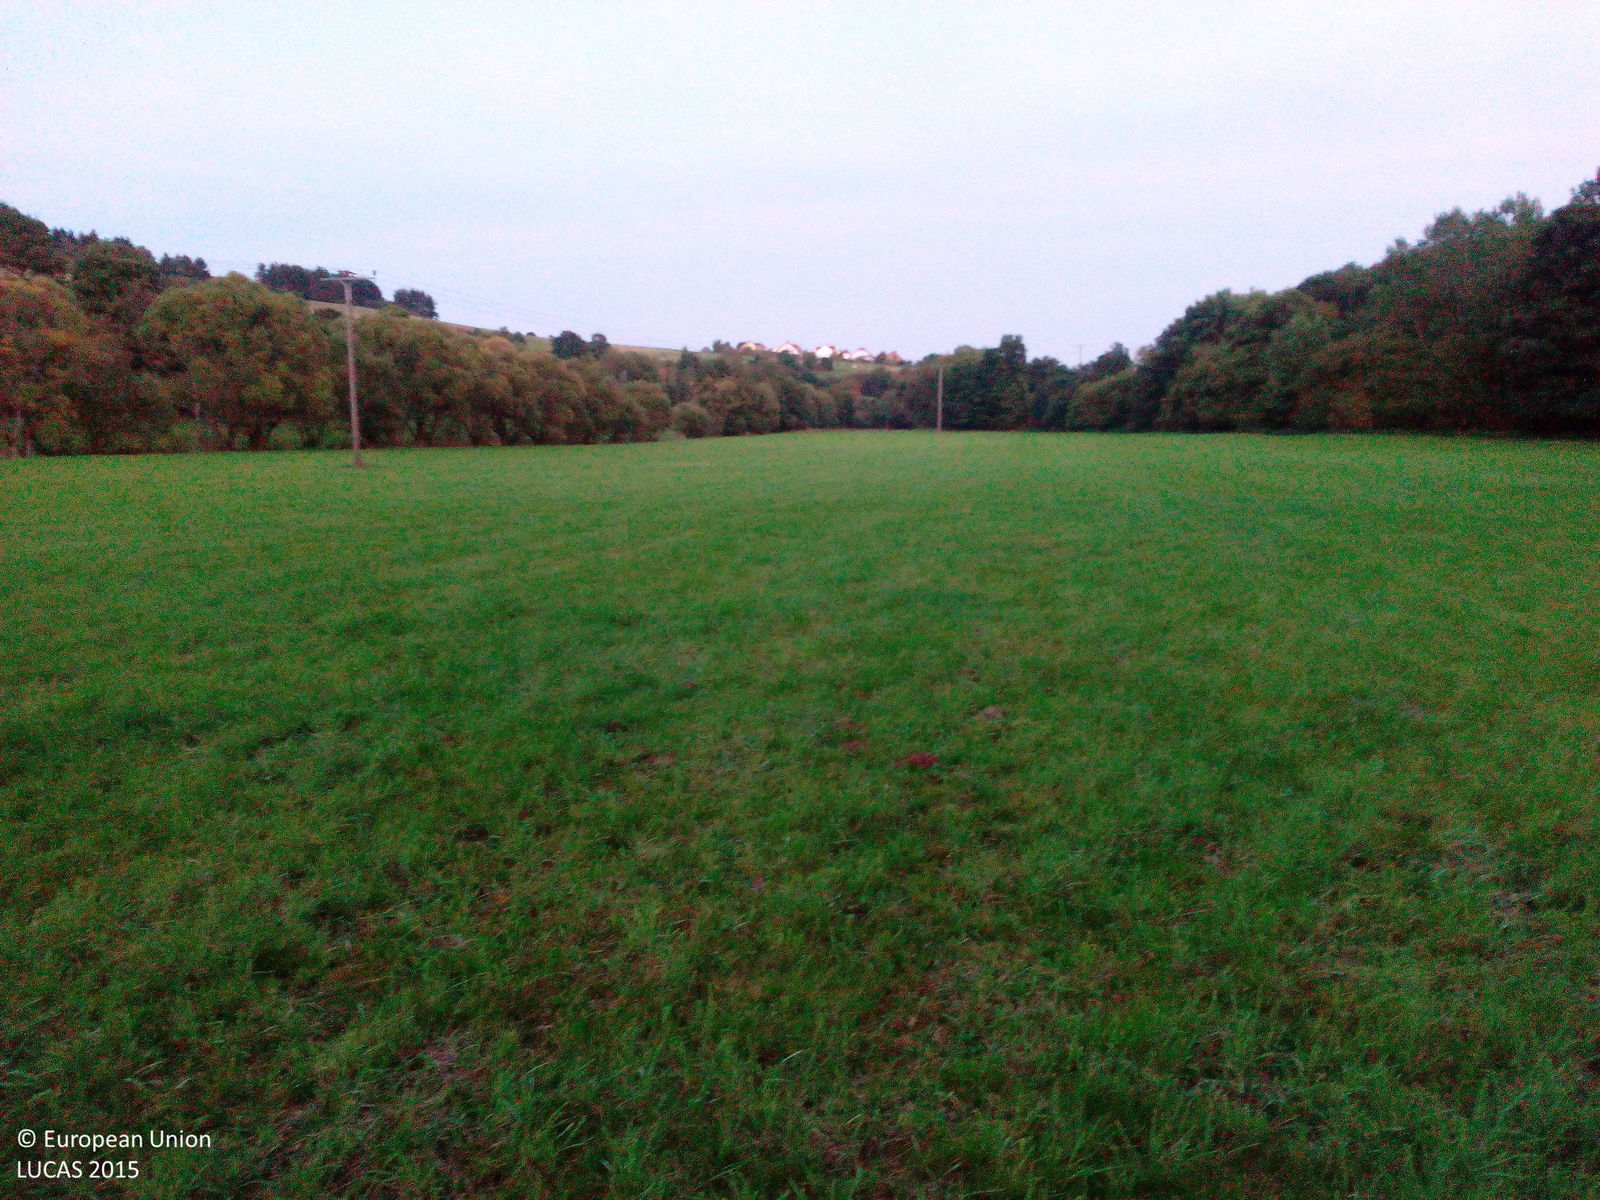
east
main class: Grassland
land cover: Grassland without tree/shrub cover
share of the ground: > 75 %
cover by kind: herbaceous plants 95 %, lichens and mosses 5 %
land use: Agriculture (excluding fallow land and kitchen gardens)
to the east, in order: Grassland without tree/shrub cover; Electric lines; Grassland without tree/shrub cover
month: September
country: DE
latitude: 50.3894
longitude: 8.4391
